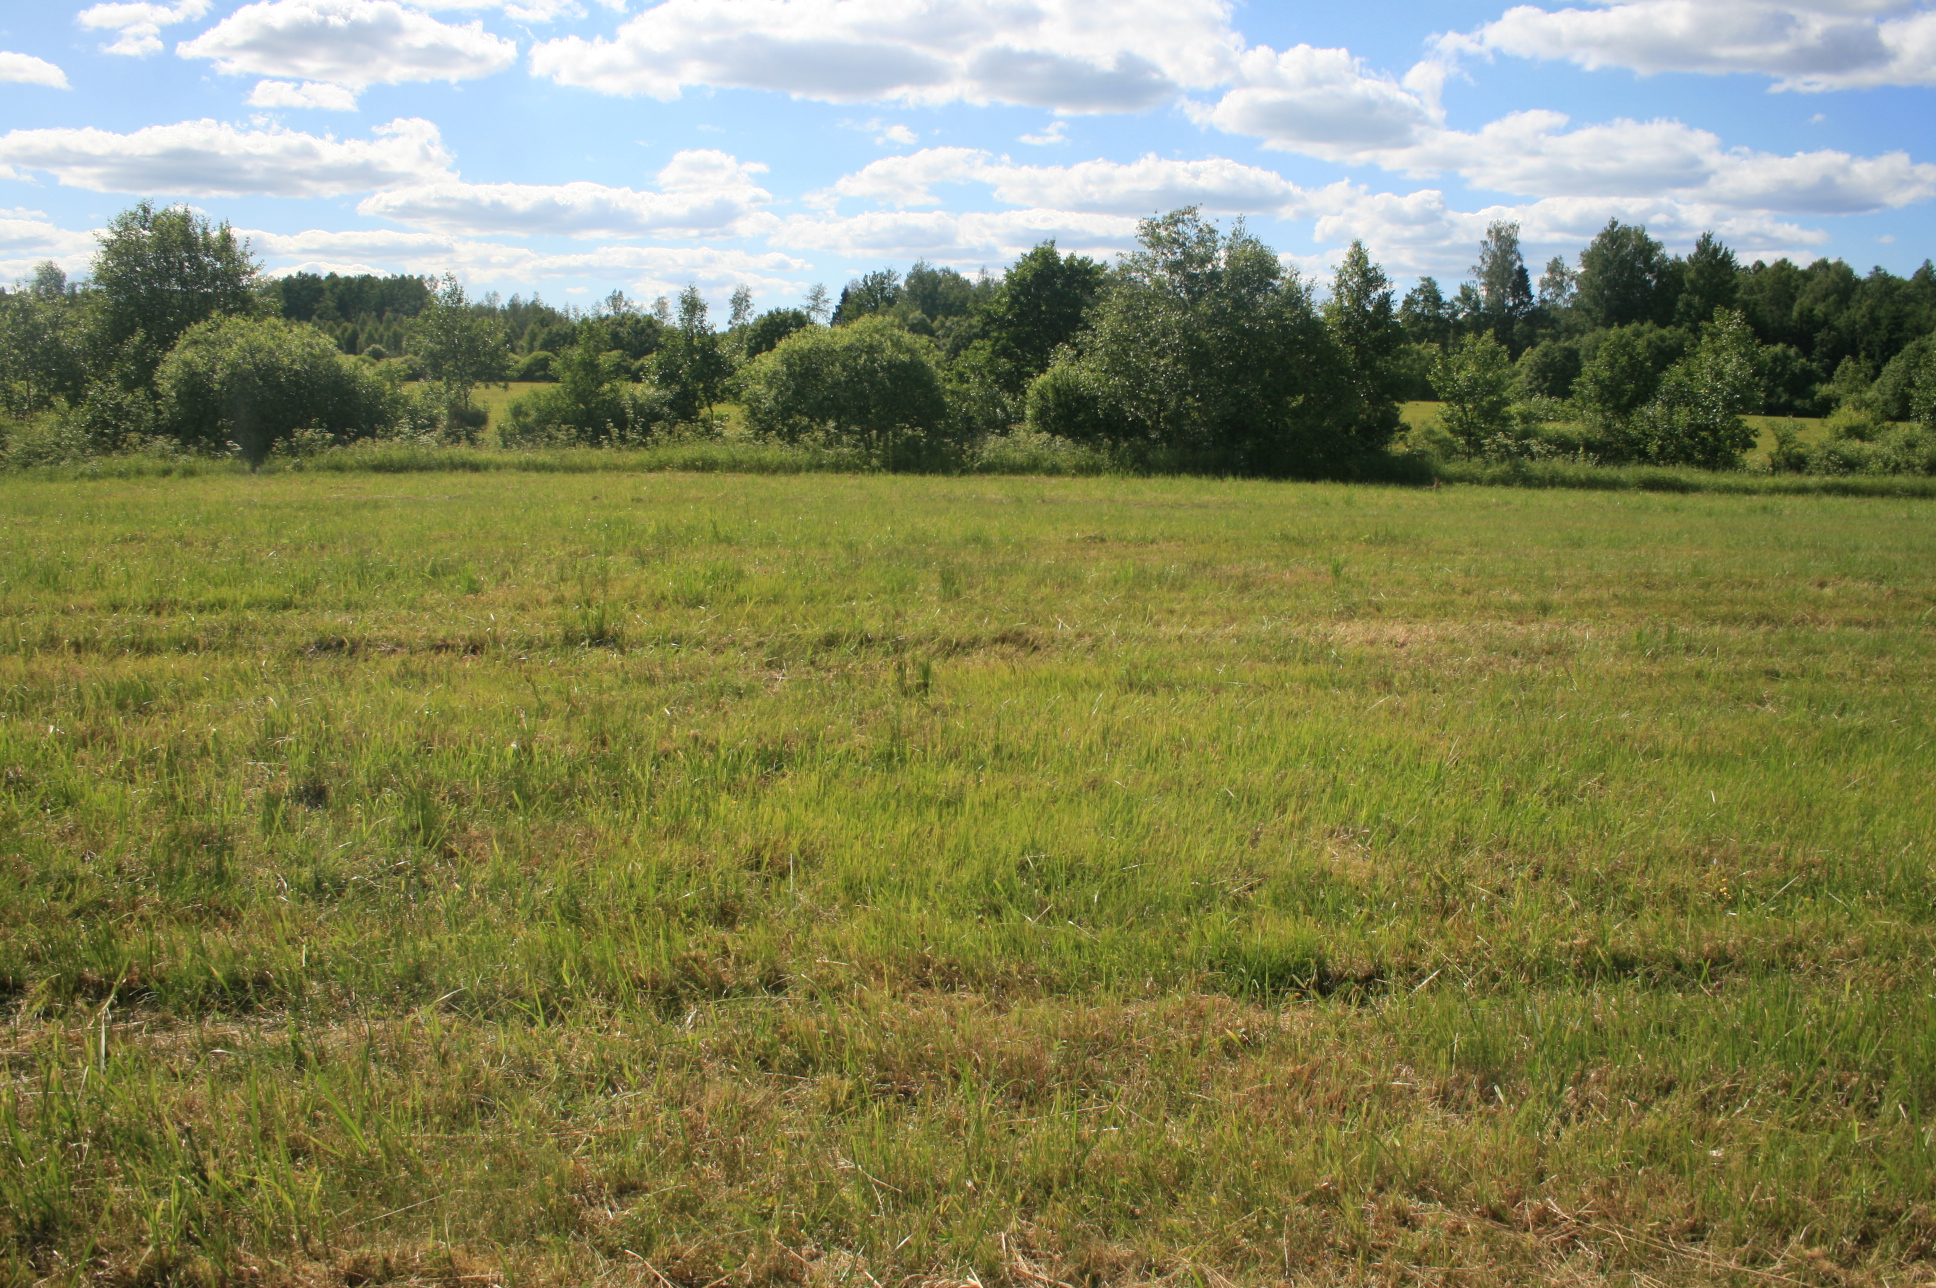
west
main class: Grassland
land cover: Grassland without tree/shrub cover
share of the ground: > 75 %
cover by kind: herbaceous plants 95 %, lichens and mosses 5 %
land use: Agriculture (excluding fallow land and kitchen gardens)
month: June
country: LT
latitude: 55.4087
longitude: 22.1380
